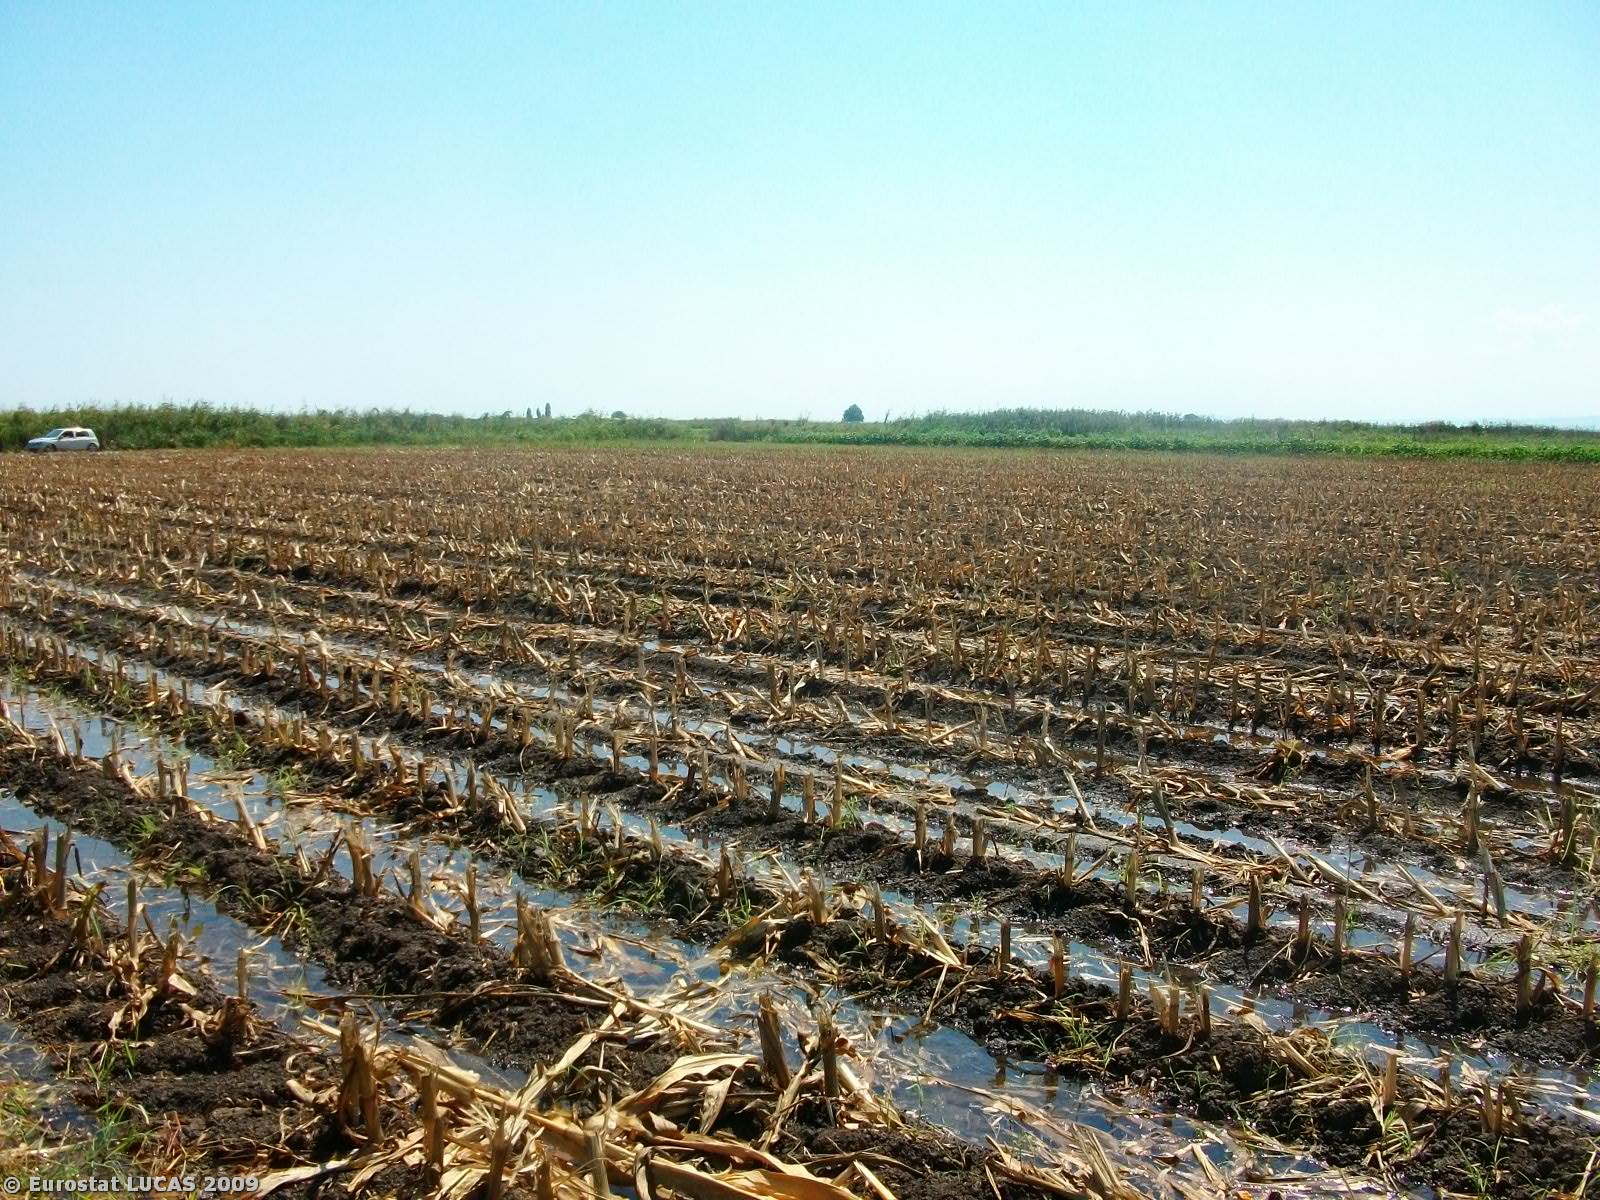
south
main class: Cropland
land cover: Cotton
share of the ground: > 75 %
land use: Agriculture (excluding fallow land and kitchen gardens)
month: August
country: GR
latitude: 40.6404
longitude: 22.5964
